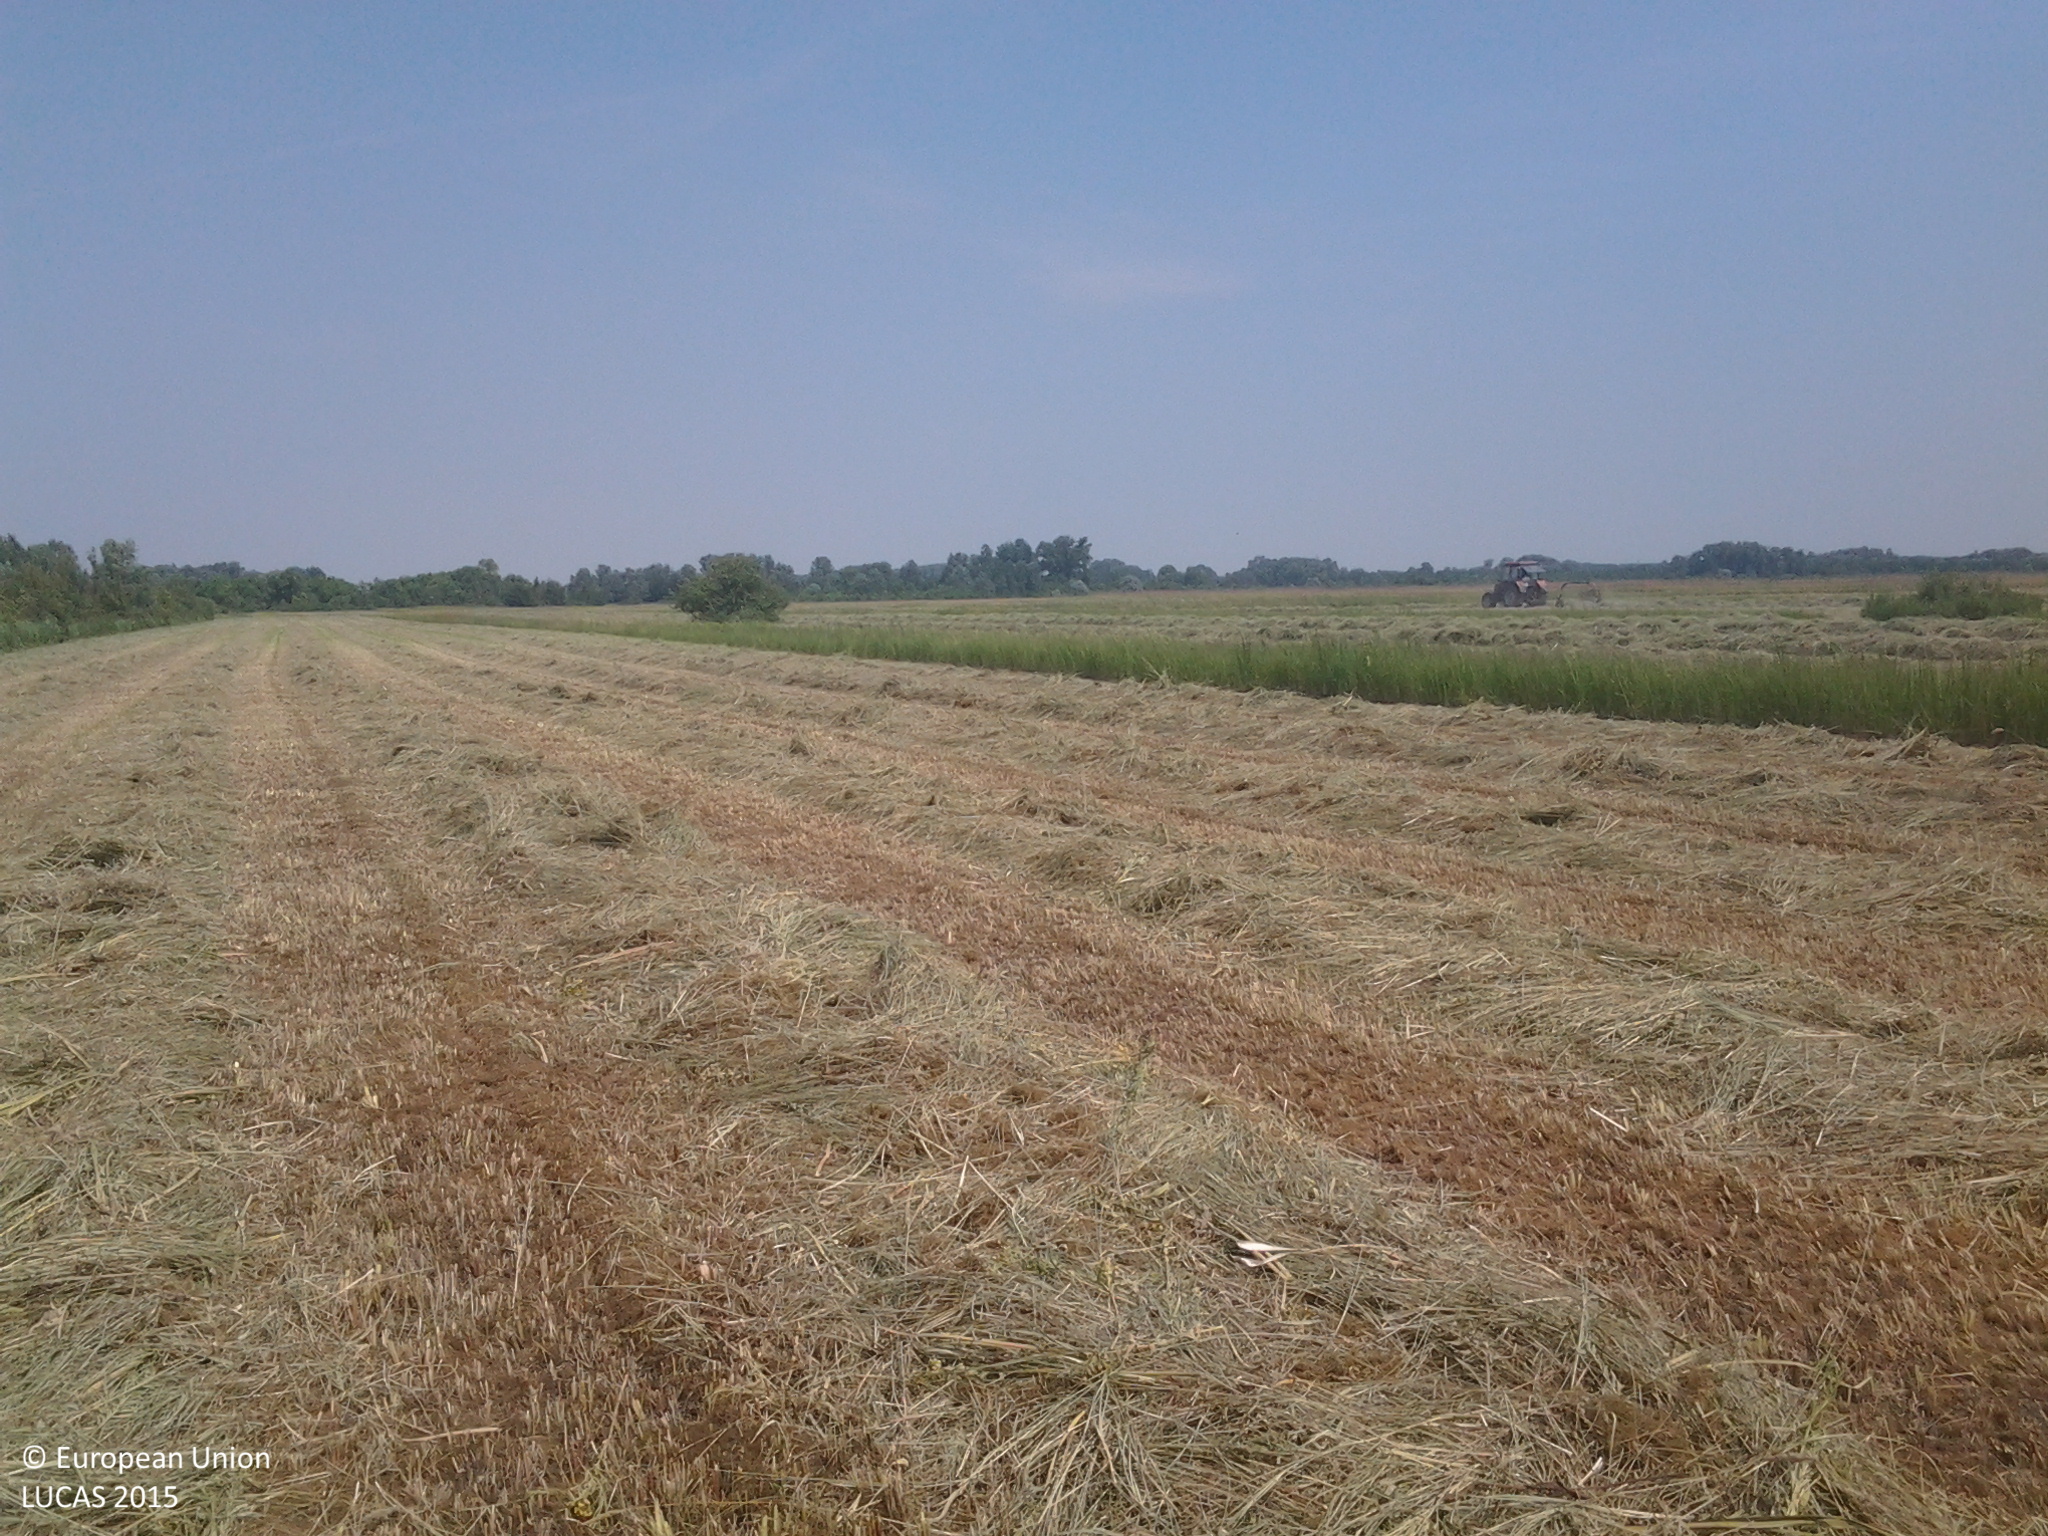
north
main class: Grassland
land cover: Grassland without tree/shrub cover
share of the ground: > 75 %
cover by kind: herbaceous plants 100 %
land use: Agriculture (excluding fallow land and kitchen gardens)
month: July
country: HU
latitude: 47.0843
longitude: 19.3309
